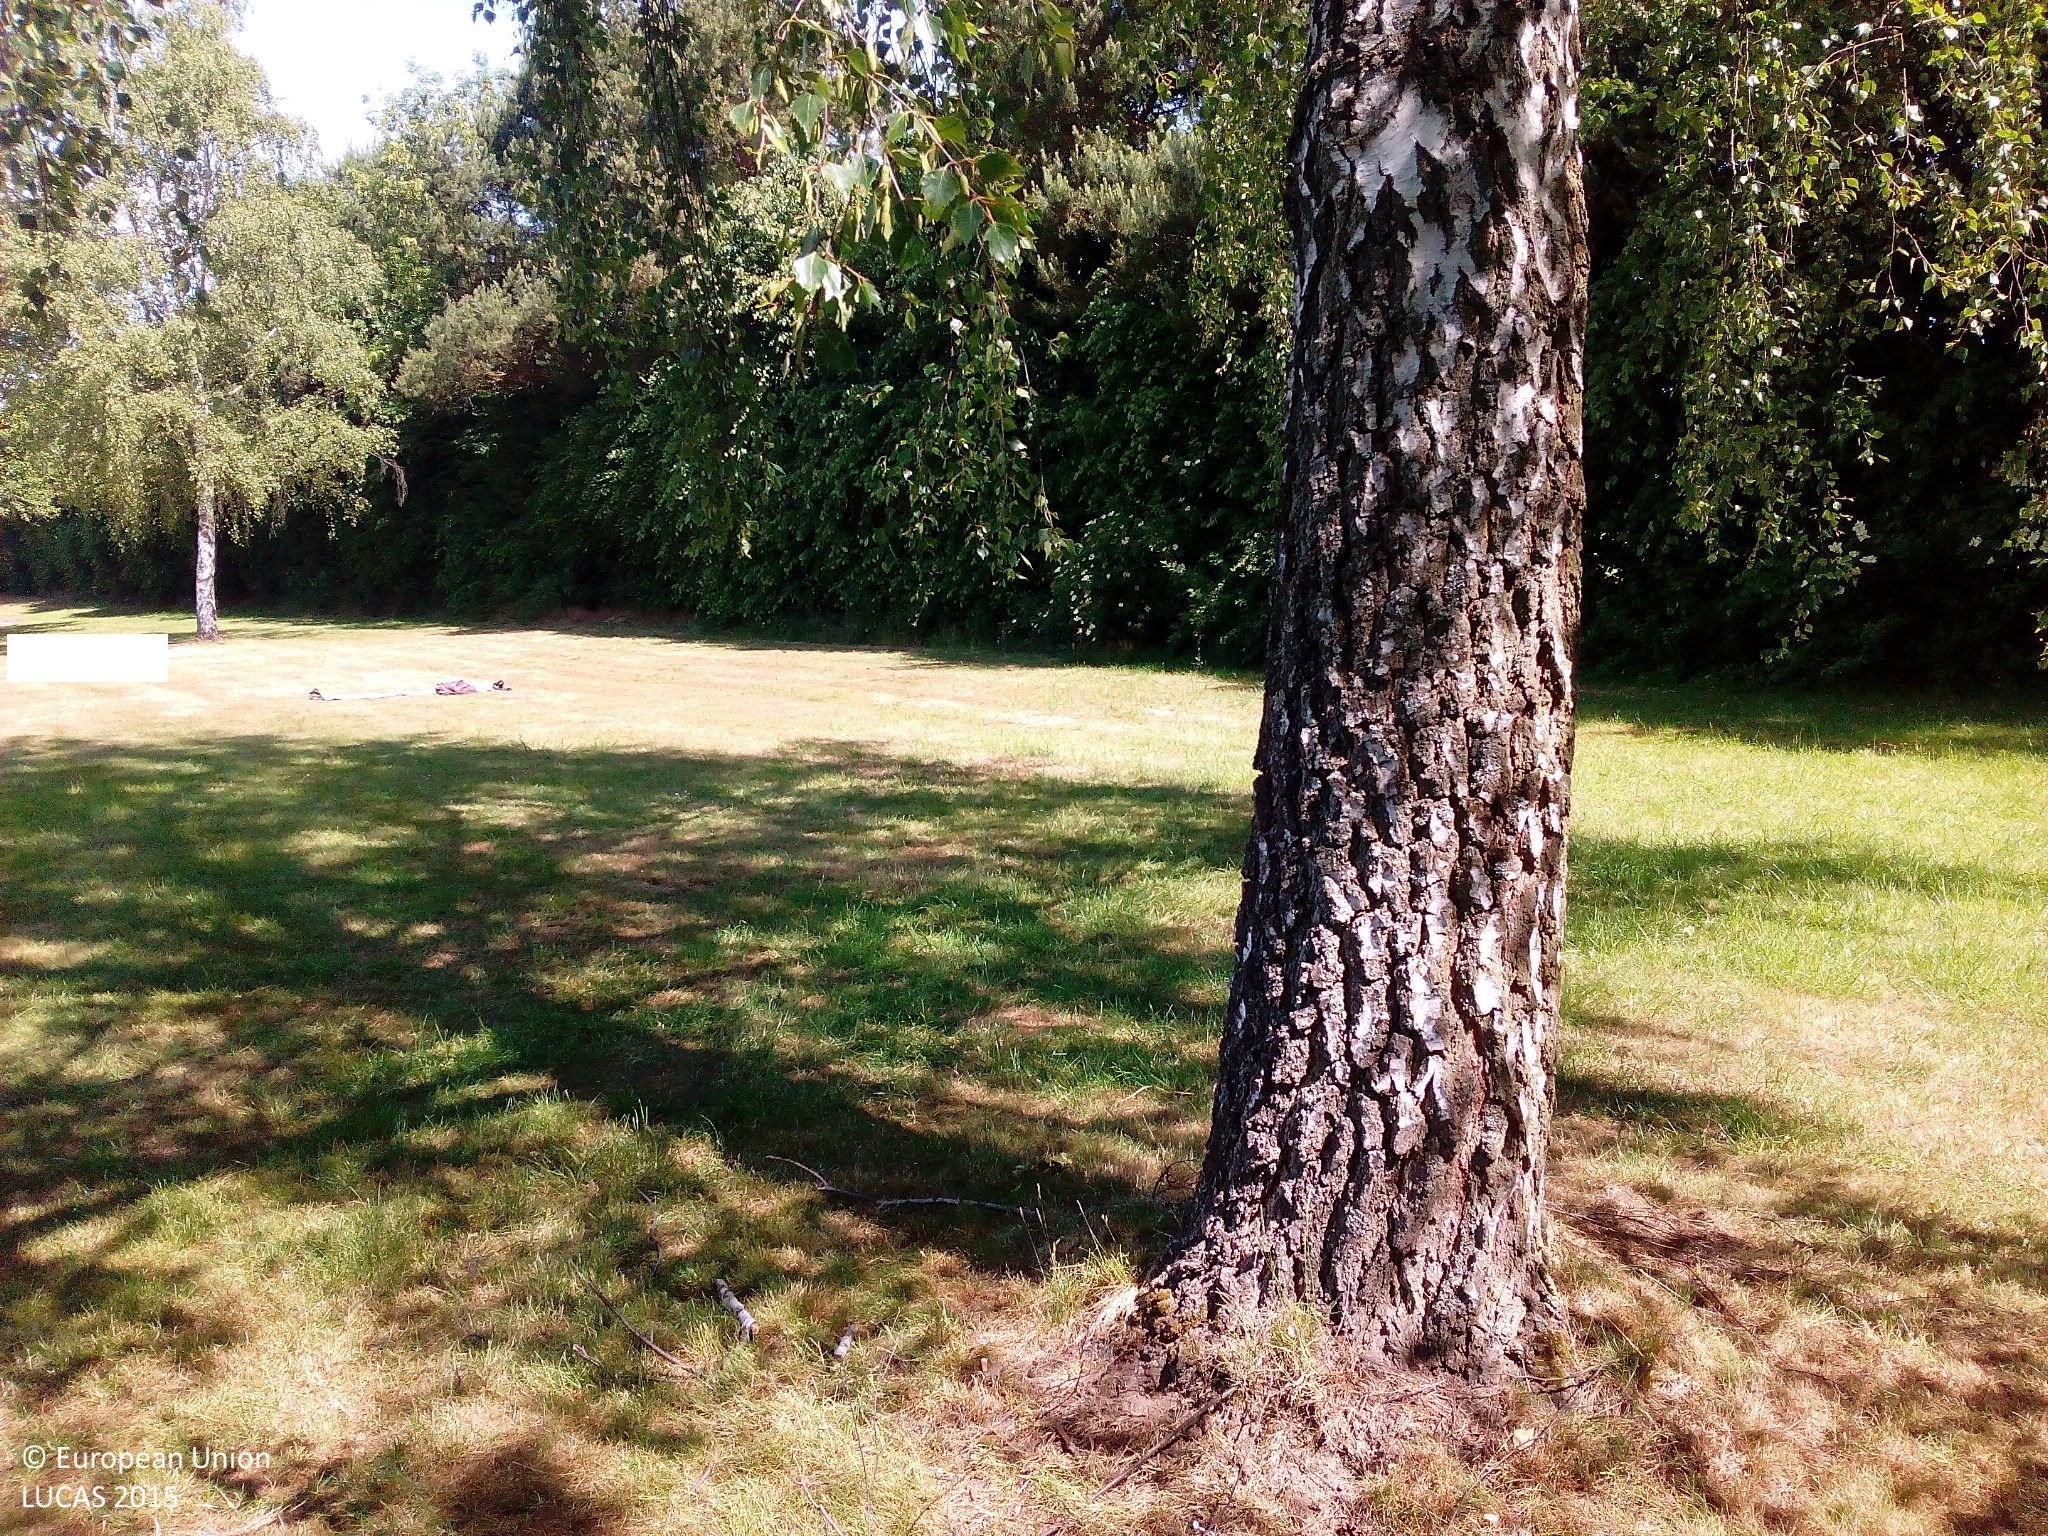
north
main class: Woodland
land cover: Broadleaved woodland
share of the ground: 50 - 75 %
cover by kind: broadleaved forest trees 70 %, herbaceous plants 30 %
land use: Amenities, museums, leisure
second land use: Sport
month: June
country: DE
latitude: 50.9190
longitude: 9.2463
